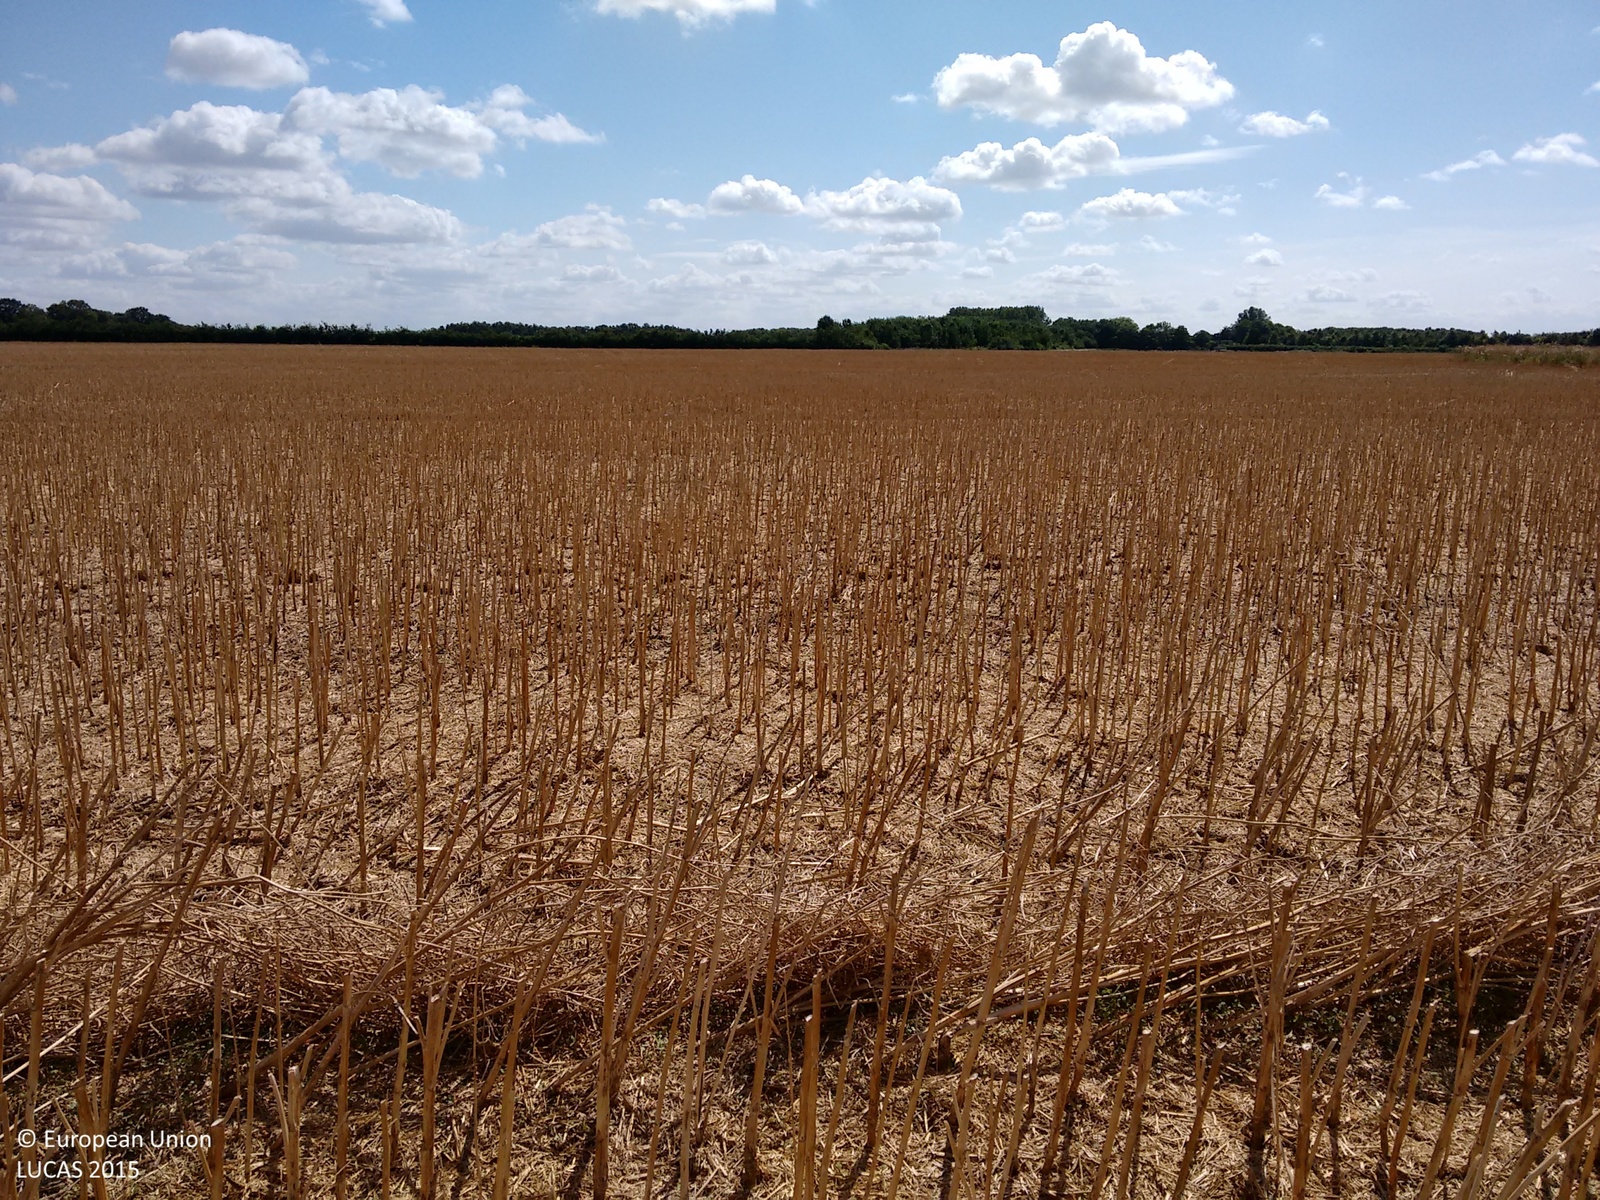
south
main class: Cropland
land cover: Rape and turnip rape
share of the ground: > 75 %
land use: Agriculture (excluding fallow land and kitchen gardens)
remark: Harvested field
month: August
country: GB
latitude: 52.7106
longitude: 0.8431
